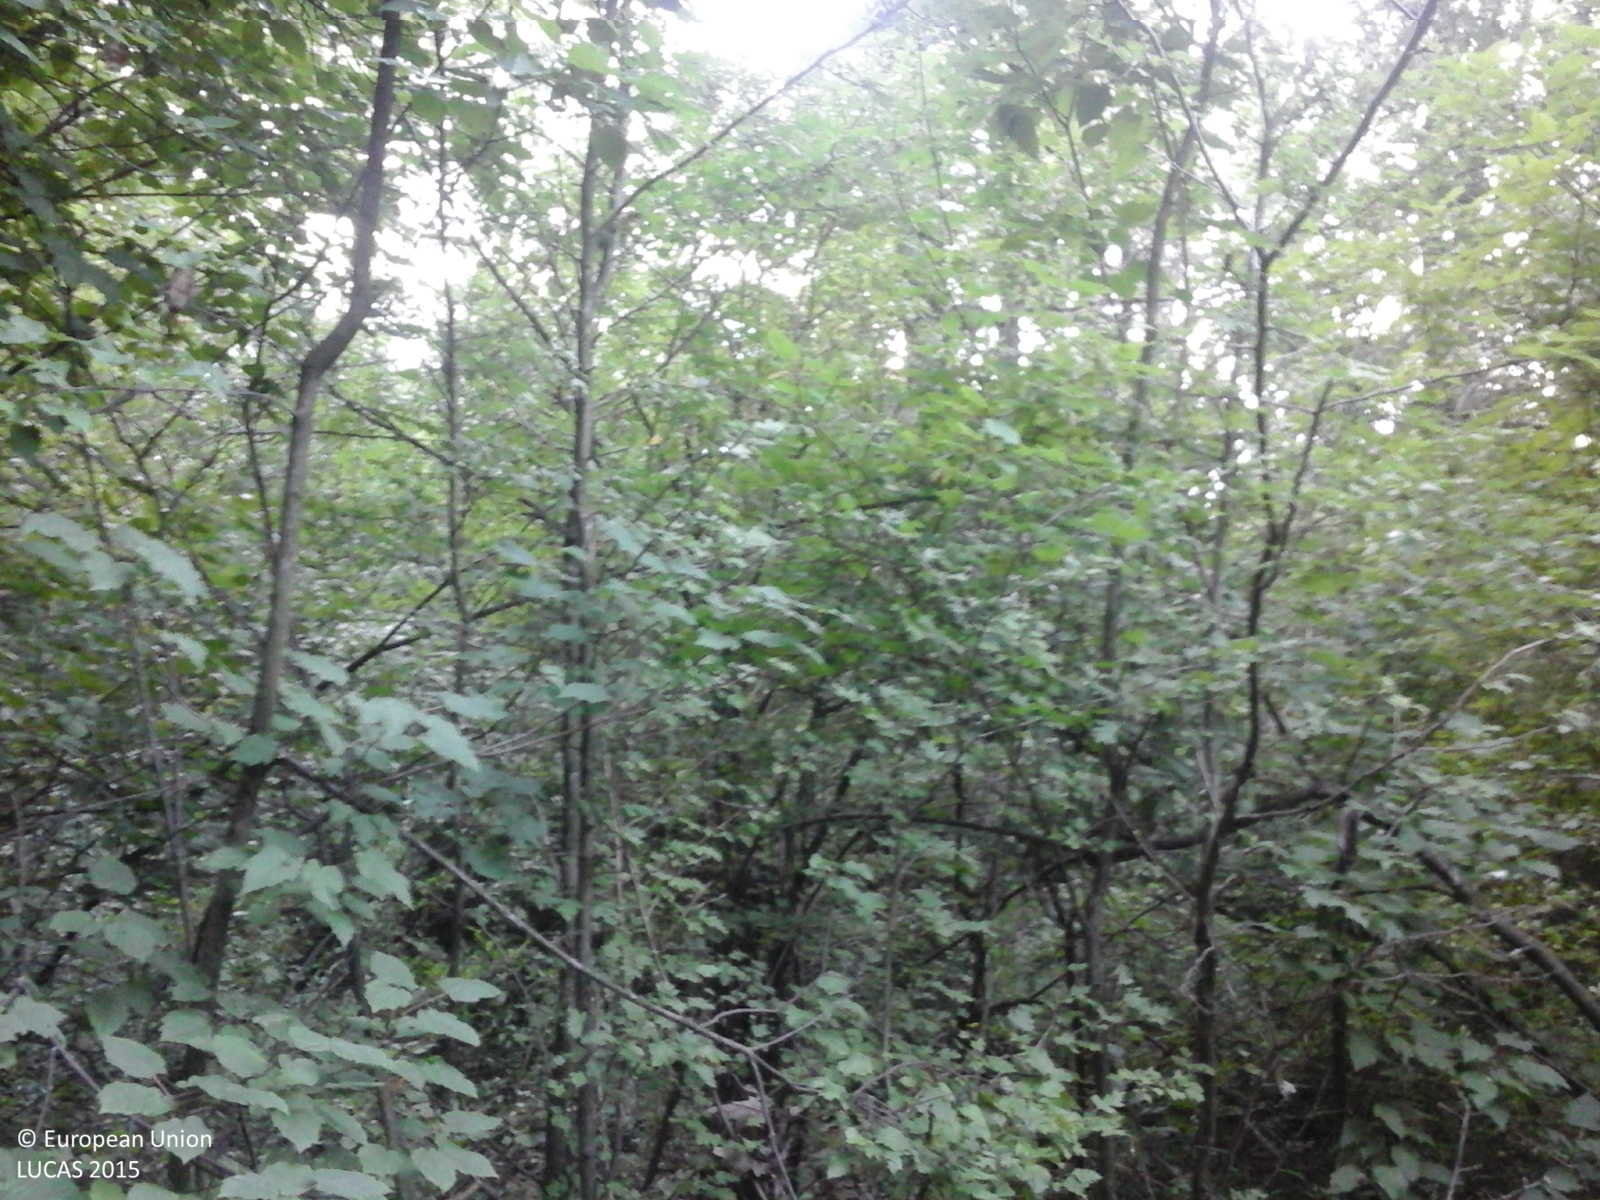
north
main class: Woodland
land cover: Broadleaved woodland
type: beech forest
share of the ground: > 75 %
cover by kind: broadleaved forest trees 100 %
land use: Forestry
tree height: > 5 m
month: July
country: RO
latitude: 44.4064
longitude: 25.4981
